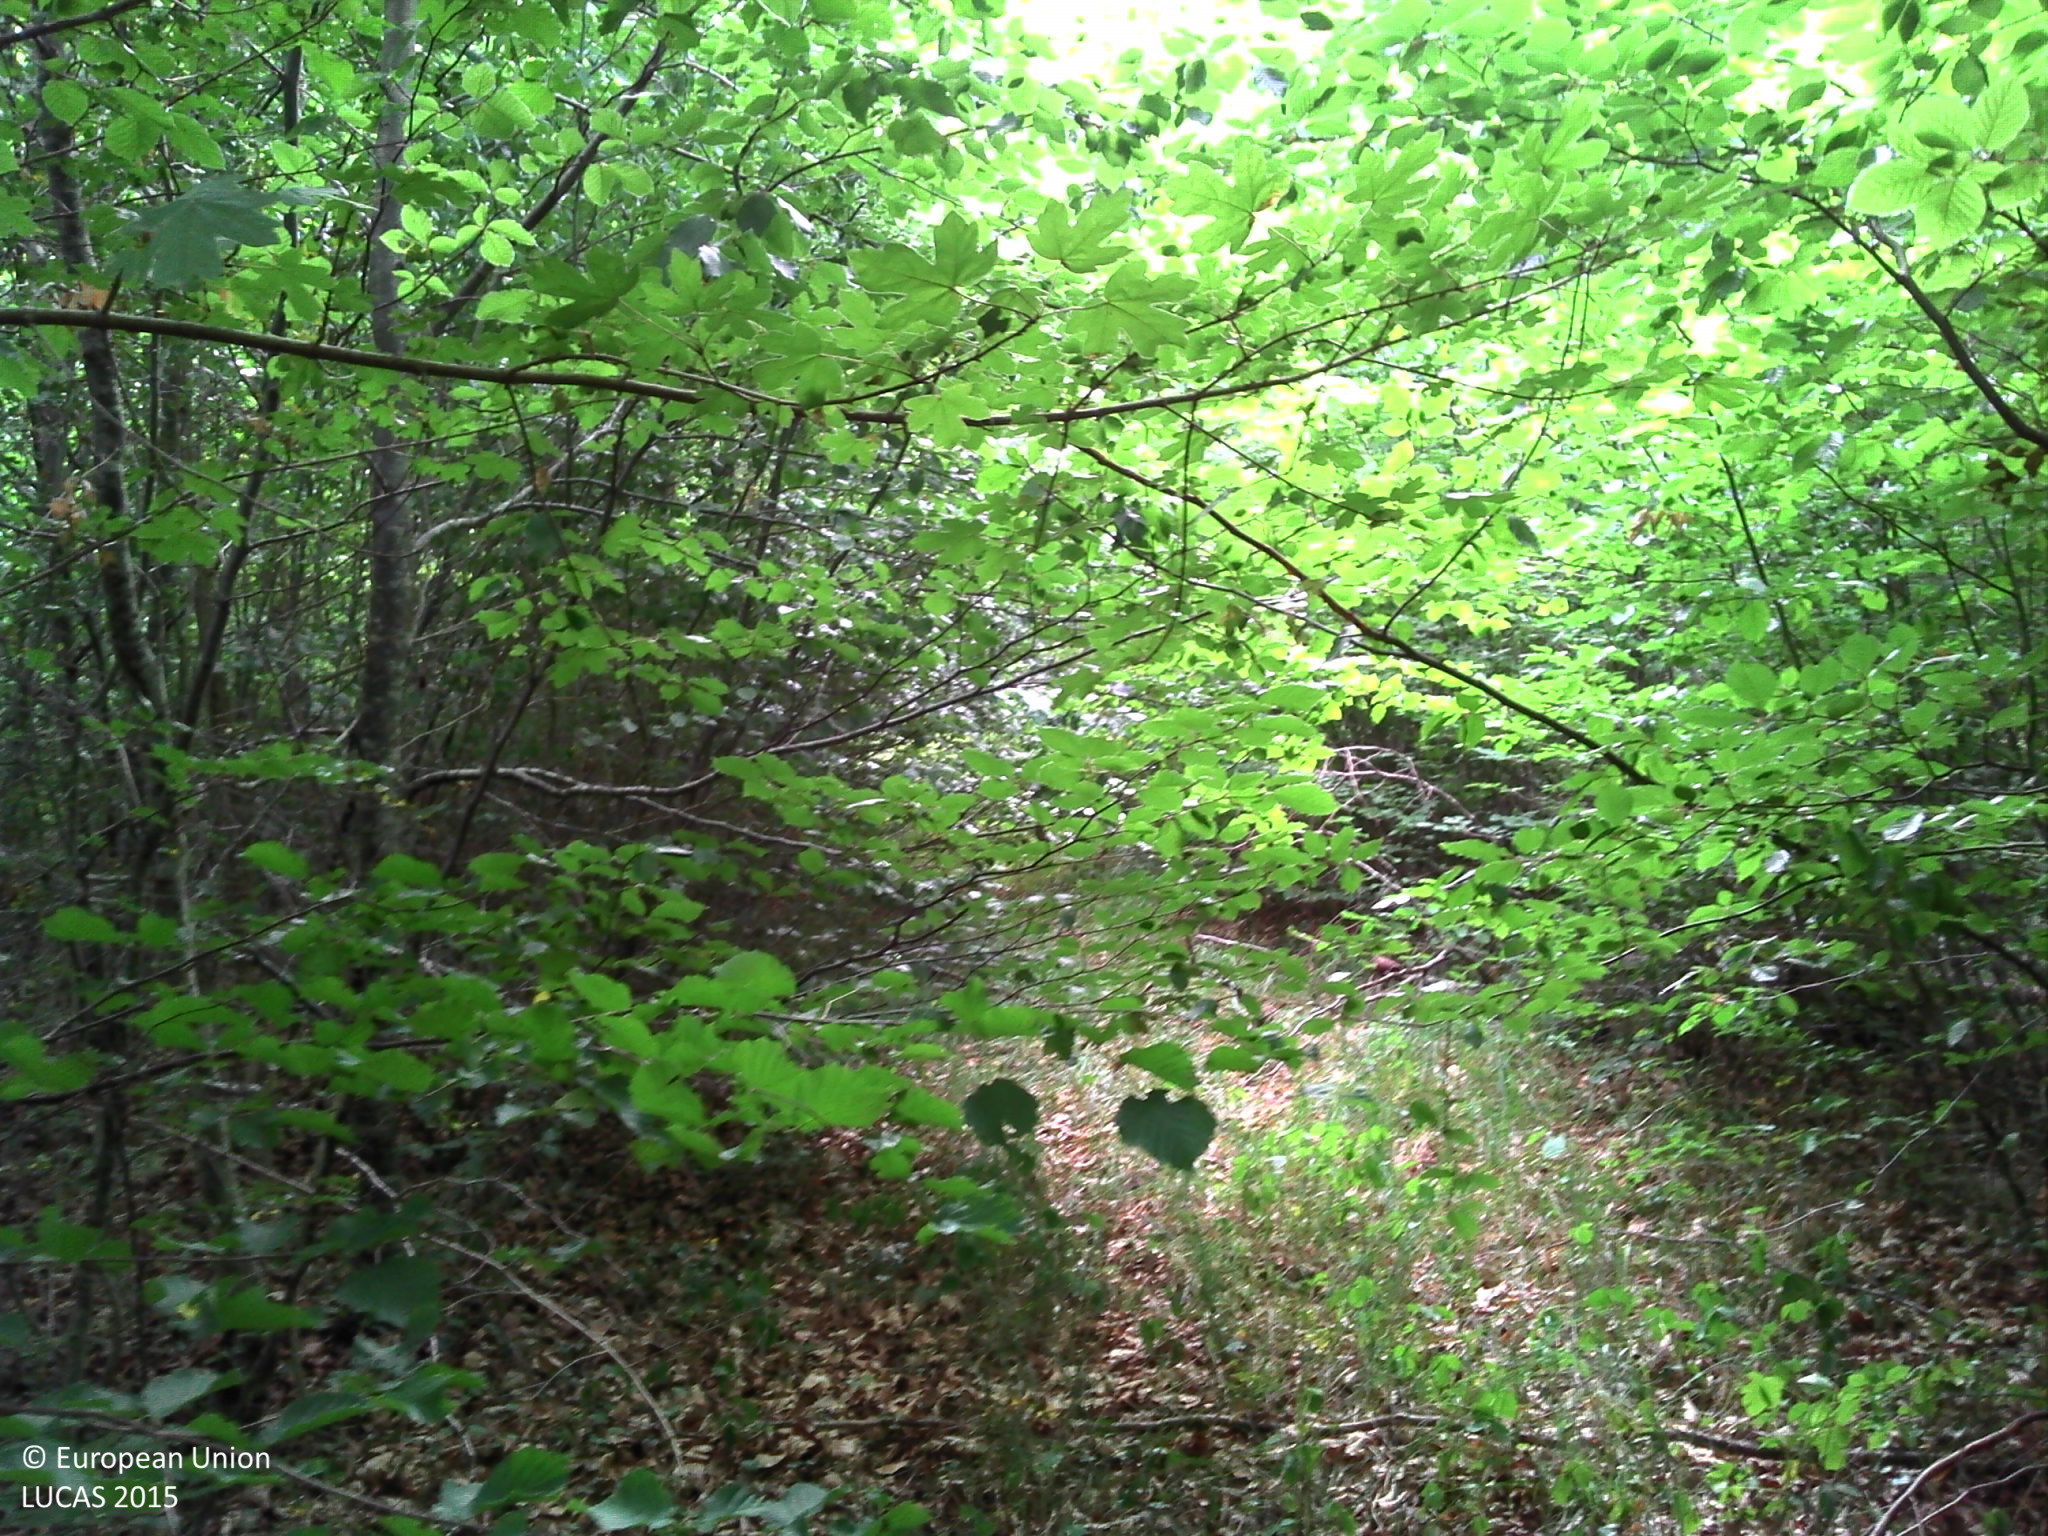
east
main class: Woodland
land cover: Broadleaved woodland
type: beech forest
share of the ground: > 75 %
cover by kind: broadleaved forest trees 80 %, herbaceous plants 10 %, shrubs 5 %, lichens and mosses 5 %
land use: Forestry
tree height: > 5 m
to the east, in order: Broadleaved woodland; Grass margins; Tracks; Grass margins; Broadleaved woodland
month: July
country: FR
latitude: 47.8296
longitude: 5.1773
